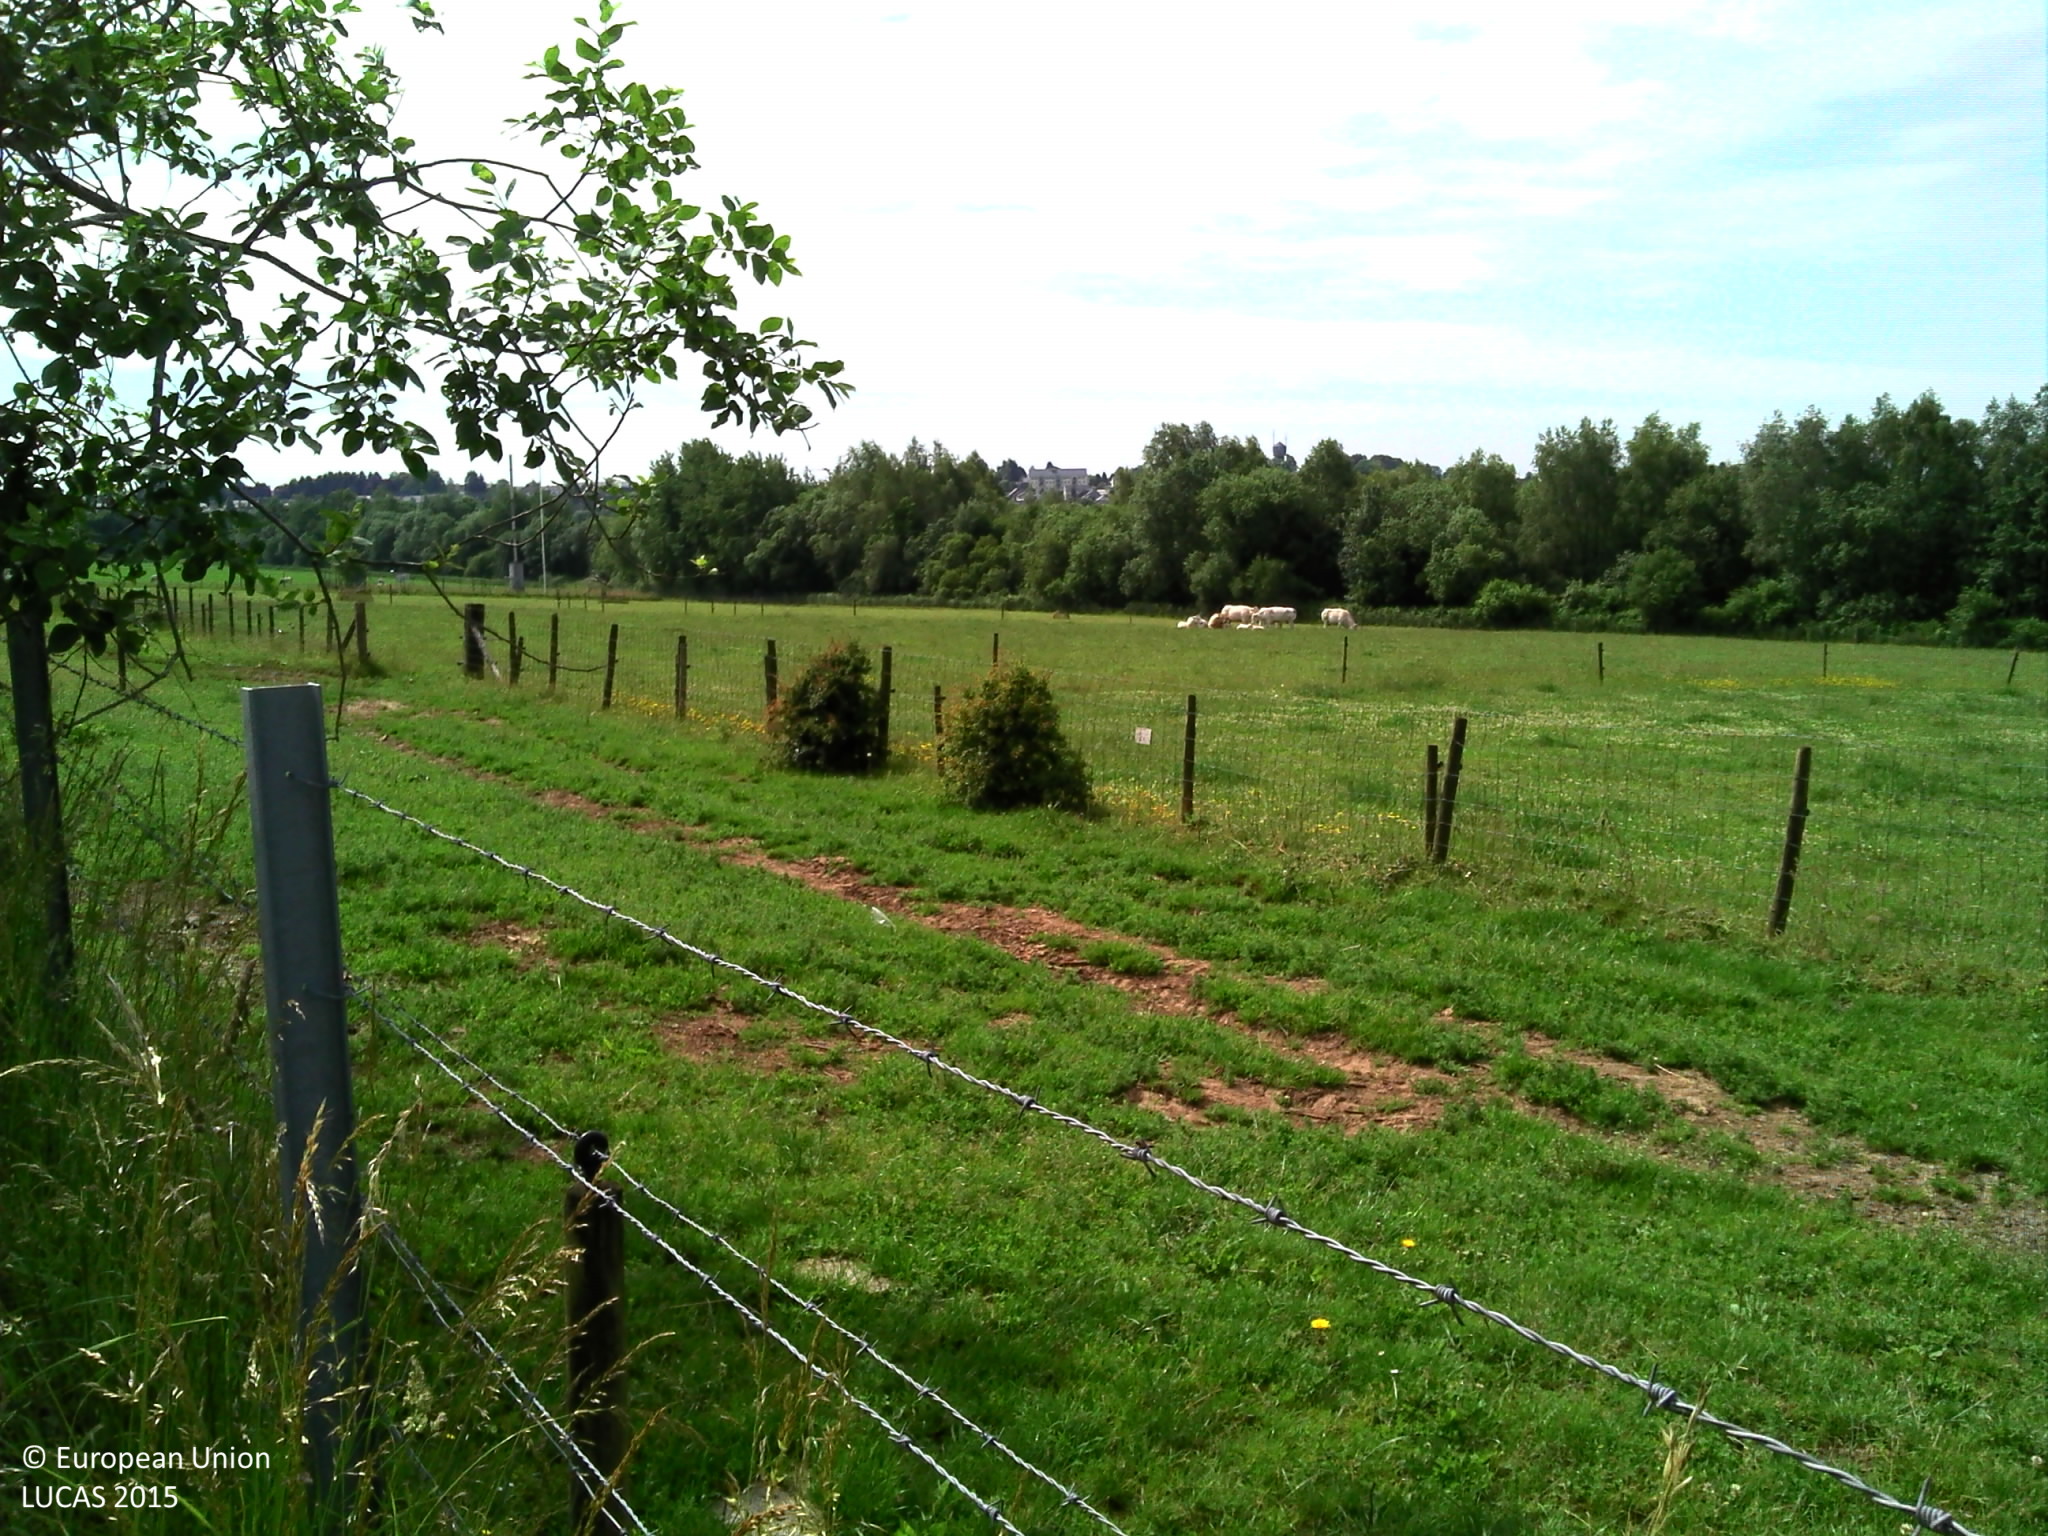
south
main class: Grassland
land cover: Grassland without tree/shrub cover
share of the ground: > 75 %
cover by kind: herbaceous plants 100 %
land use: Agriculture (excluding fallow land and kitchen gardens)
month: June
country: BE
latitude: 49.9277
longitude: 5.3593
